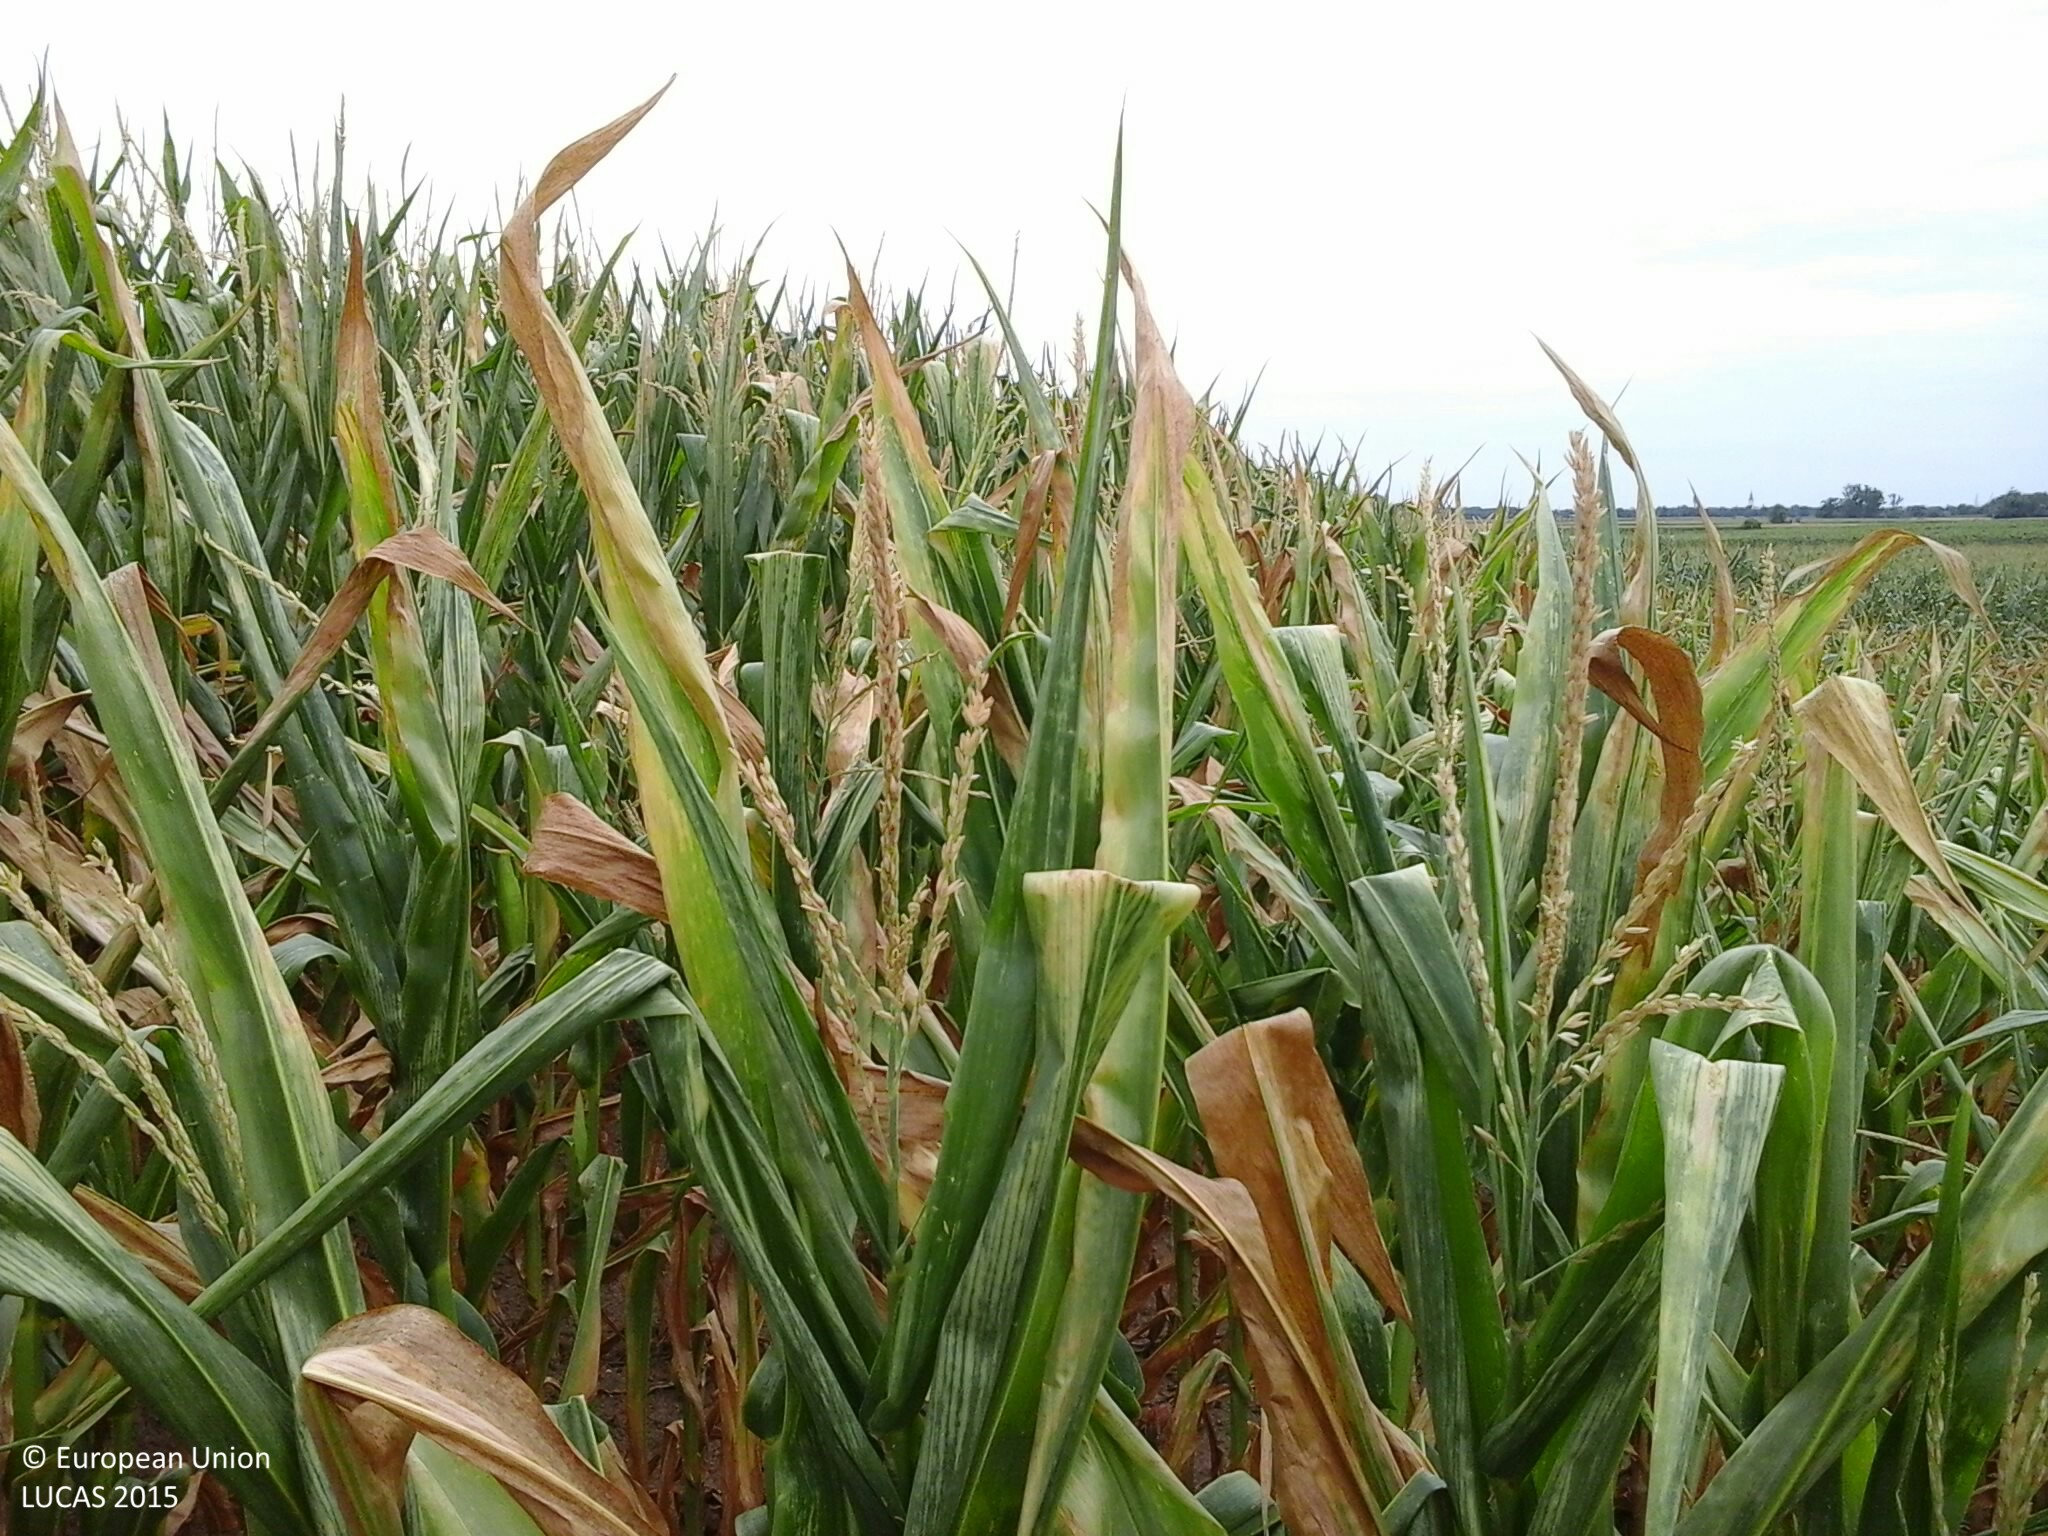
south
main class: Cropland
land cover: Maize
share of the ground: > 75 %
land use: Agriculture (excluding fallow land and kitchen gardens)
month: July
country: HU
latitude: 47.8792
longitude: 21.4498
